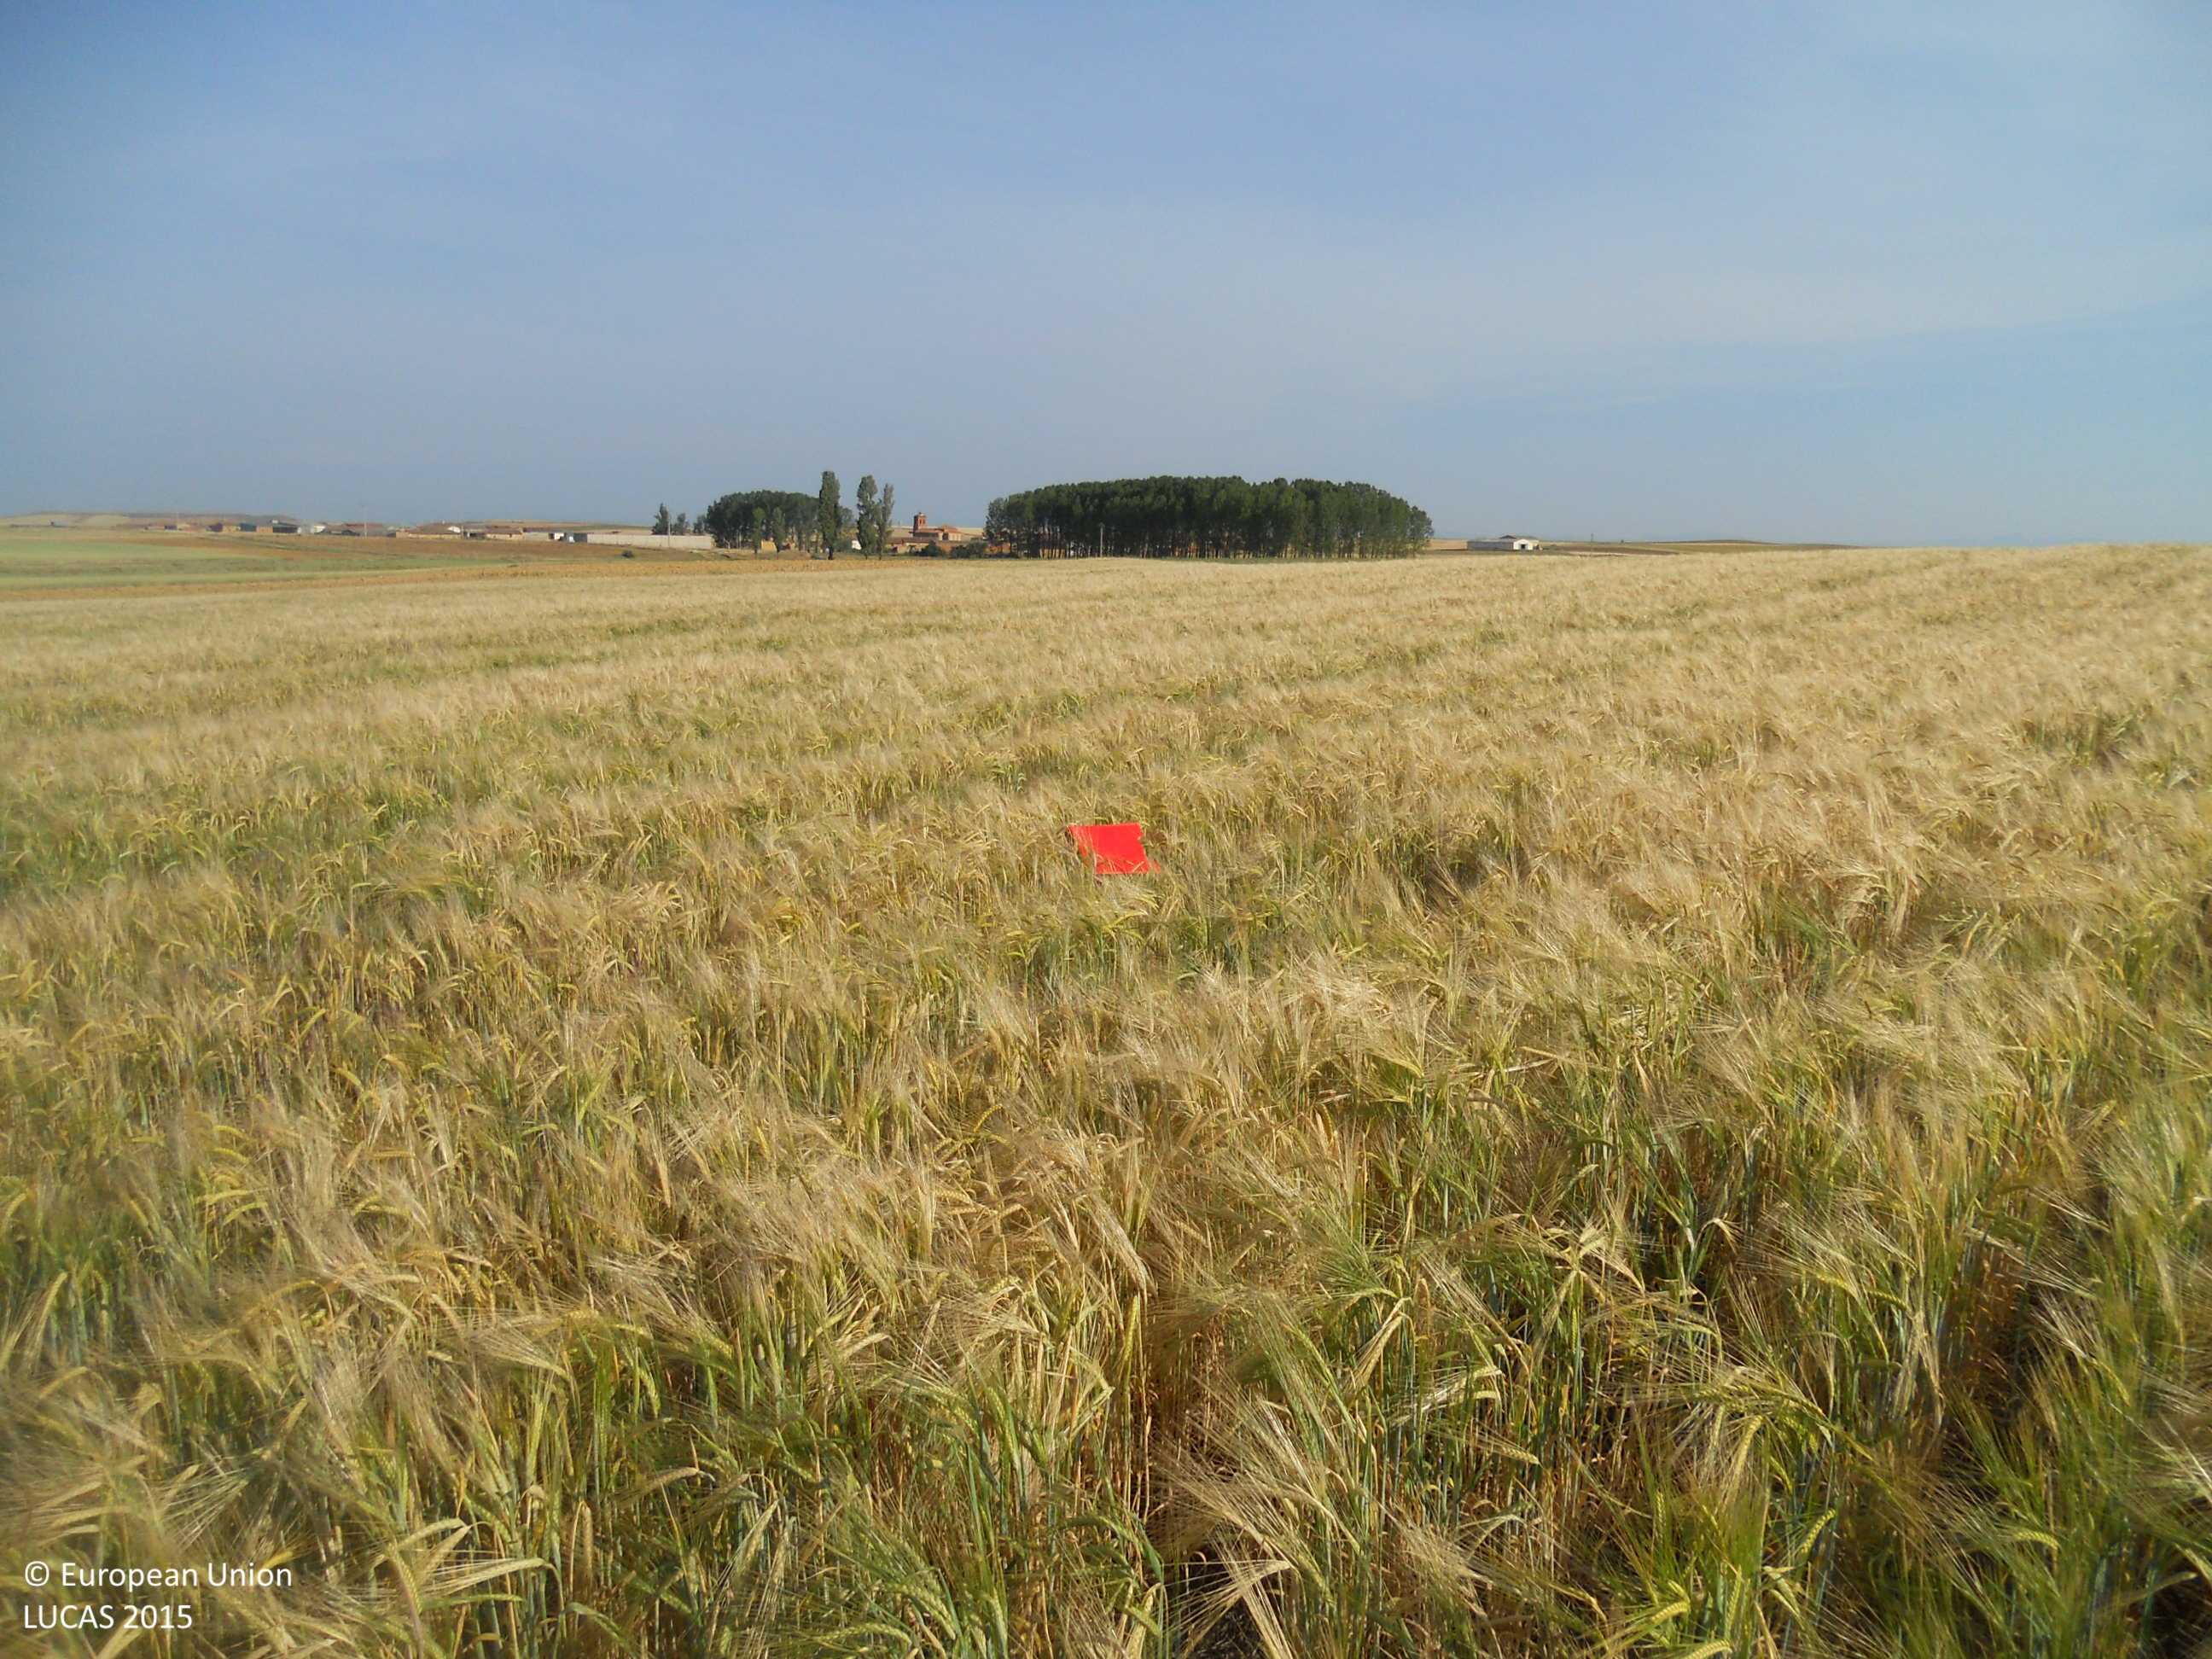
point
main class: Cropland
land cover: Barley
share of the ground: > 75 %
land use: Agriculture (excluding fallow land and kitchen gardens)
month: June
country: ES
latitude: 42.3882
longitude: -5.3837
